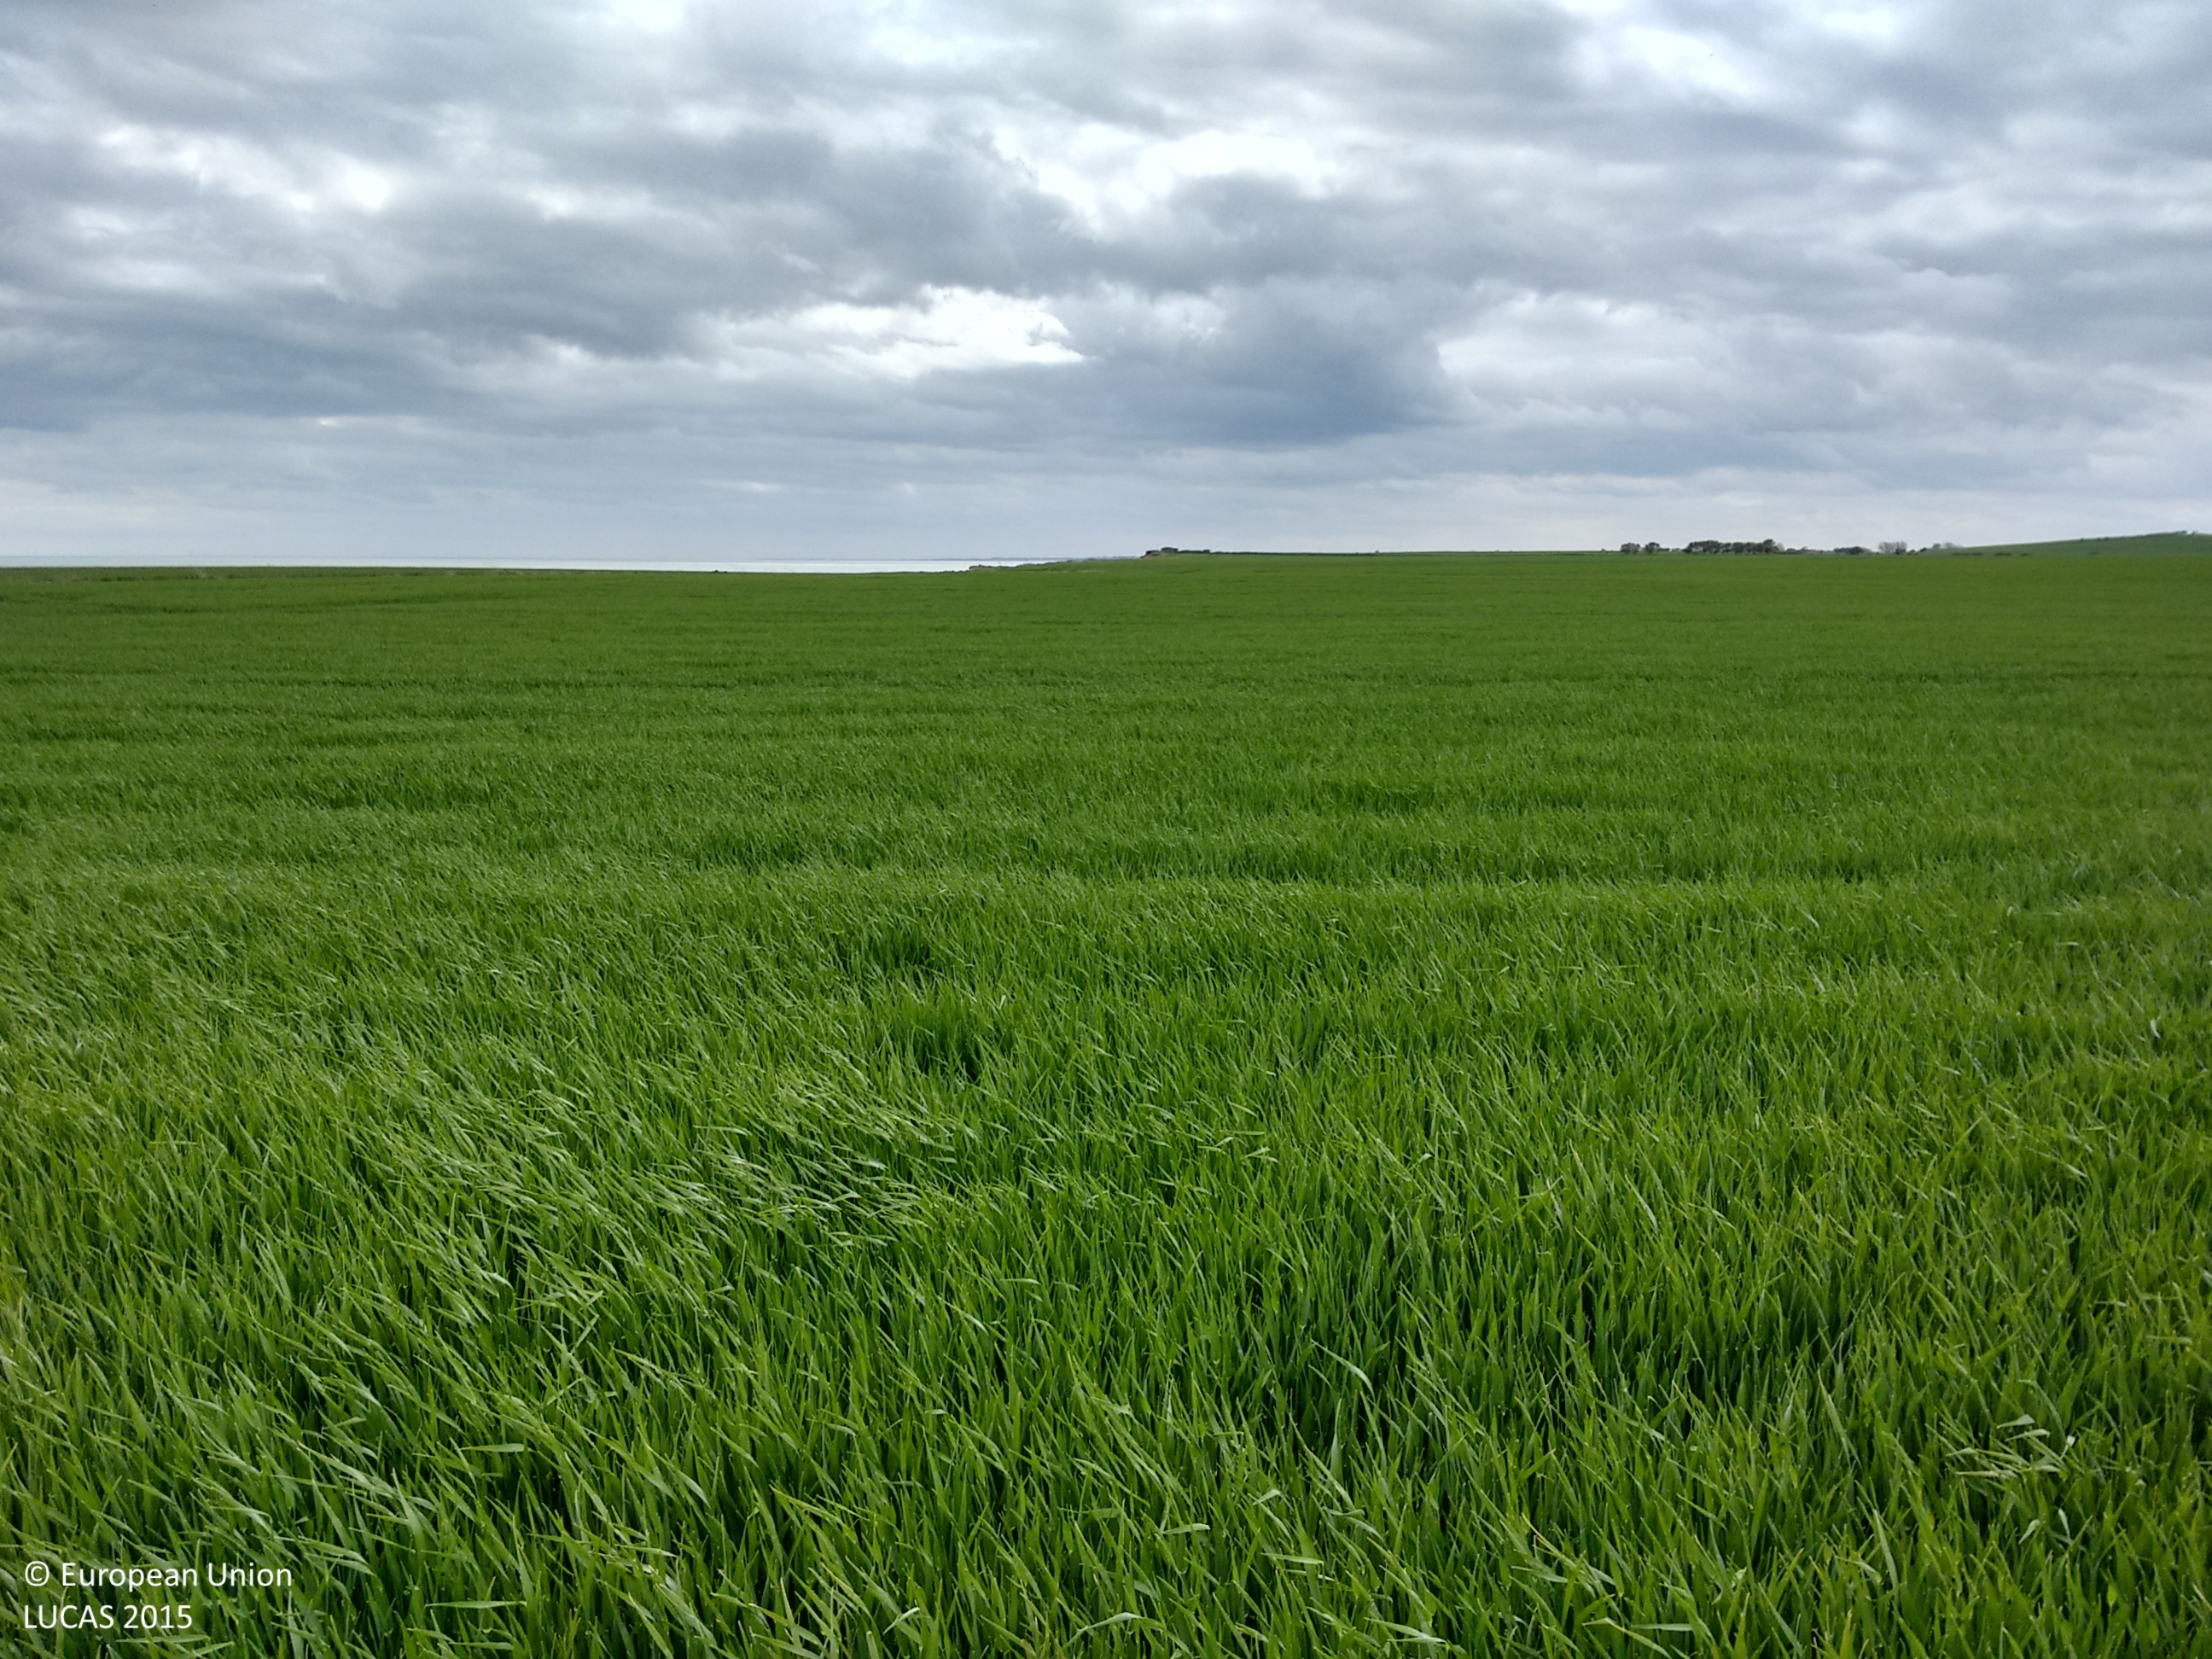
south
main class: Cropland
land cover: Barley
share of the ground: > 75 %
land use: Agriculture (excluding fallow land and kitchen gardens)
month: May
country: GB
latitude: 54.0381
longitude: -0.2181
